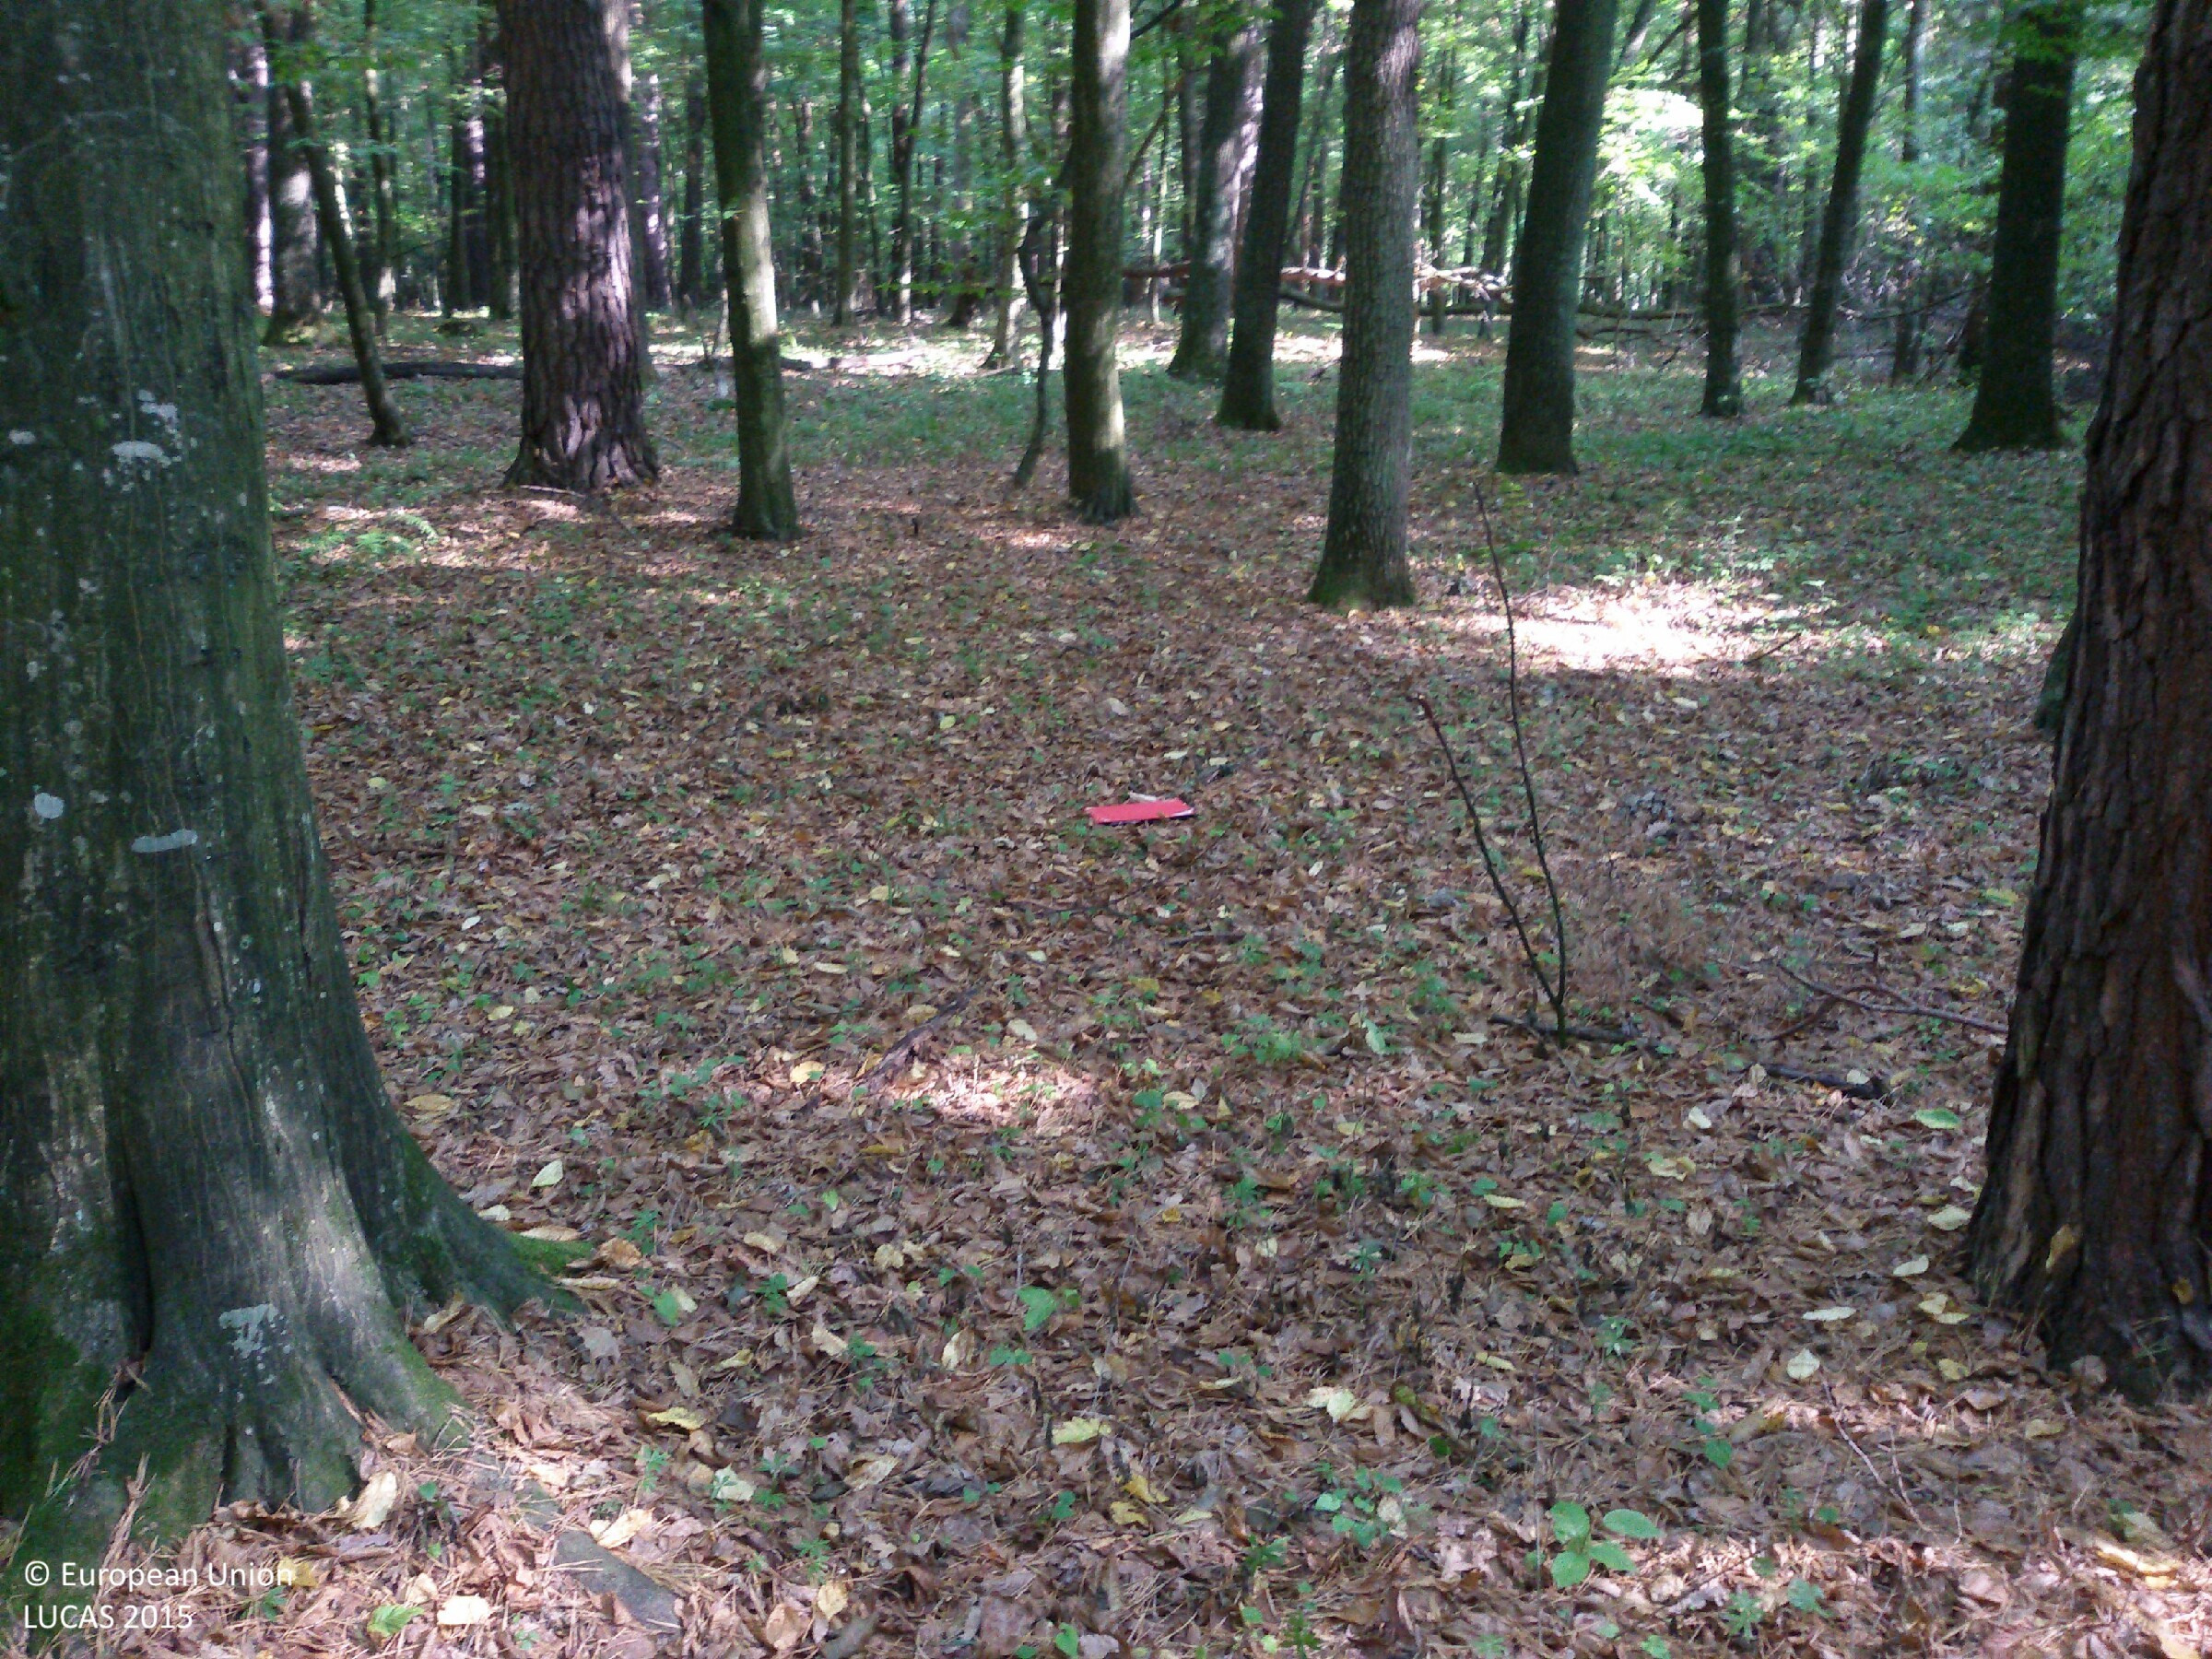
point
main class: Woodland
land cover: Broadleaved woodland
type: mesophytic deciduous forest
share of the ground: > 75 %
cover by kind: broadleaved forest trees 90 %, herbaceous plants 10 %
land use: Forestry
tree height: > 5 m
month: September
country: PL
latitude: 50.7078
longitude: 23.9564
